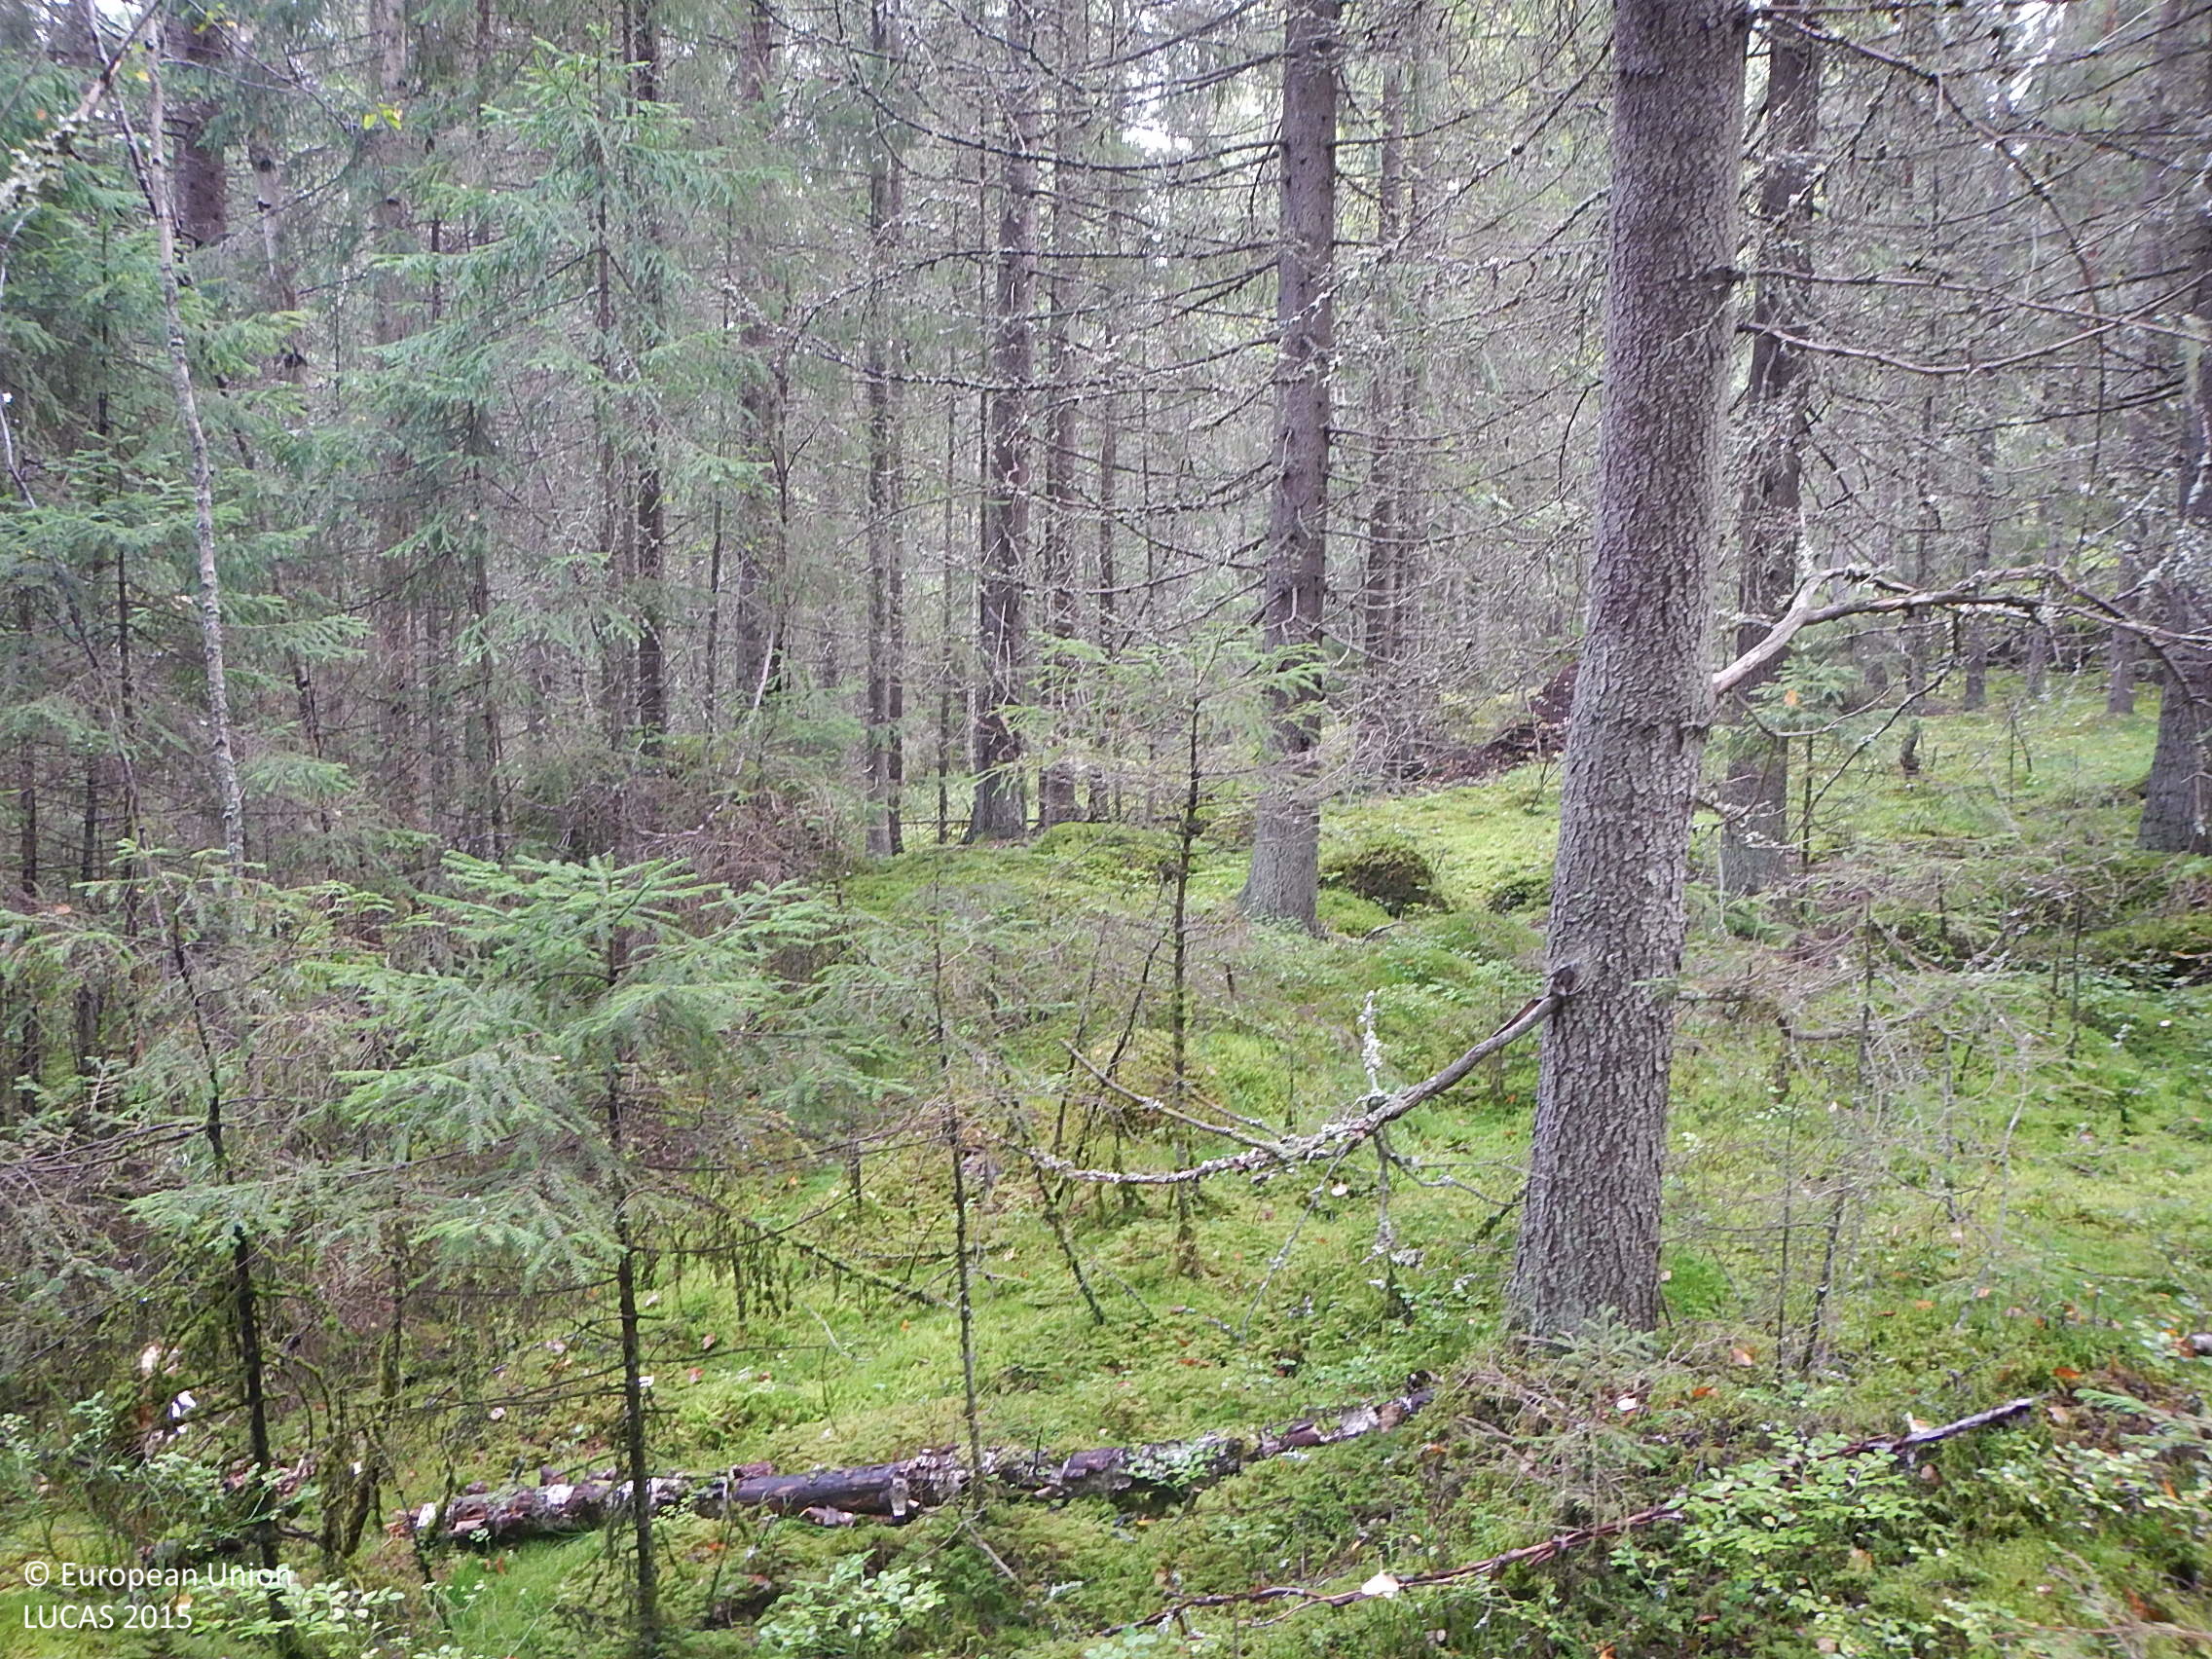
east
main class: Woodland
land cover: Spruce dominated mixed woodland
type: boreal forest
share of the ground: > 75 %
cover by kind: coniferous forest trees 50 %, broadleaved forest trees 25 %, lichens and mosses 20 %, shrubs 5 %
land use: Forestry
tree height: > 5 m
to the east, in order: Spruce dominated mixed woodland; Tracks; Other mixed woodland
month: September
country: FI
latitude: 61.4886
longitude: 23.0870
